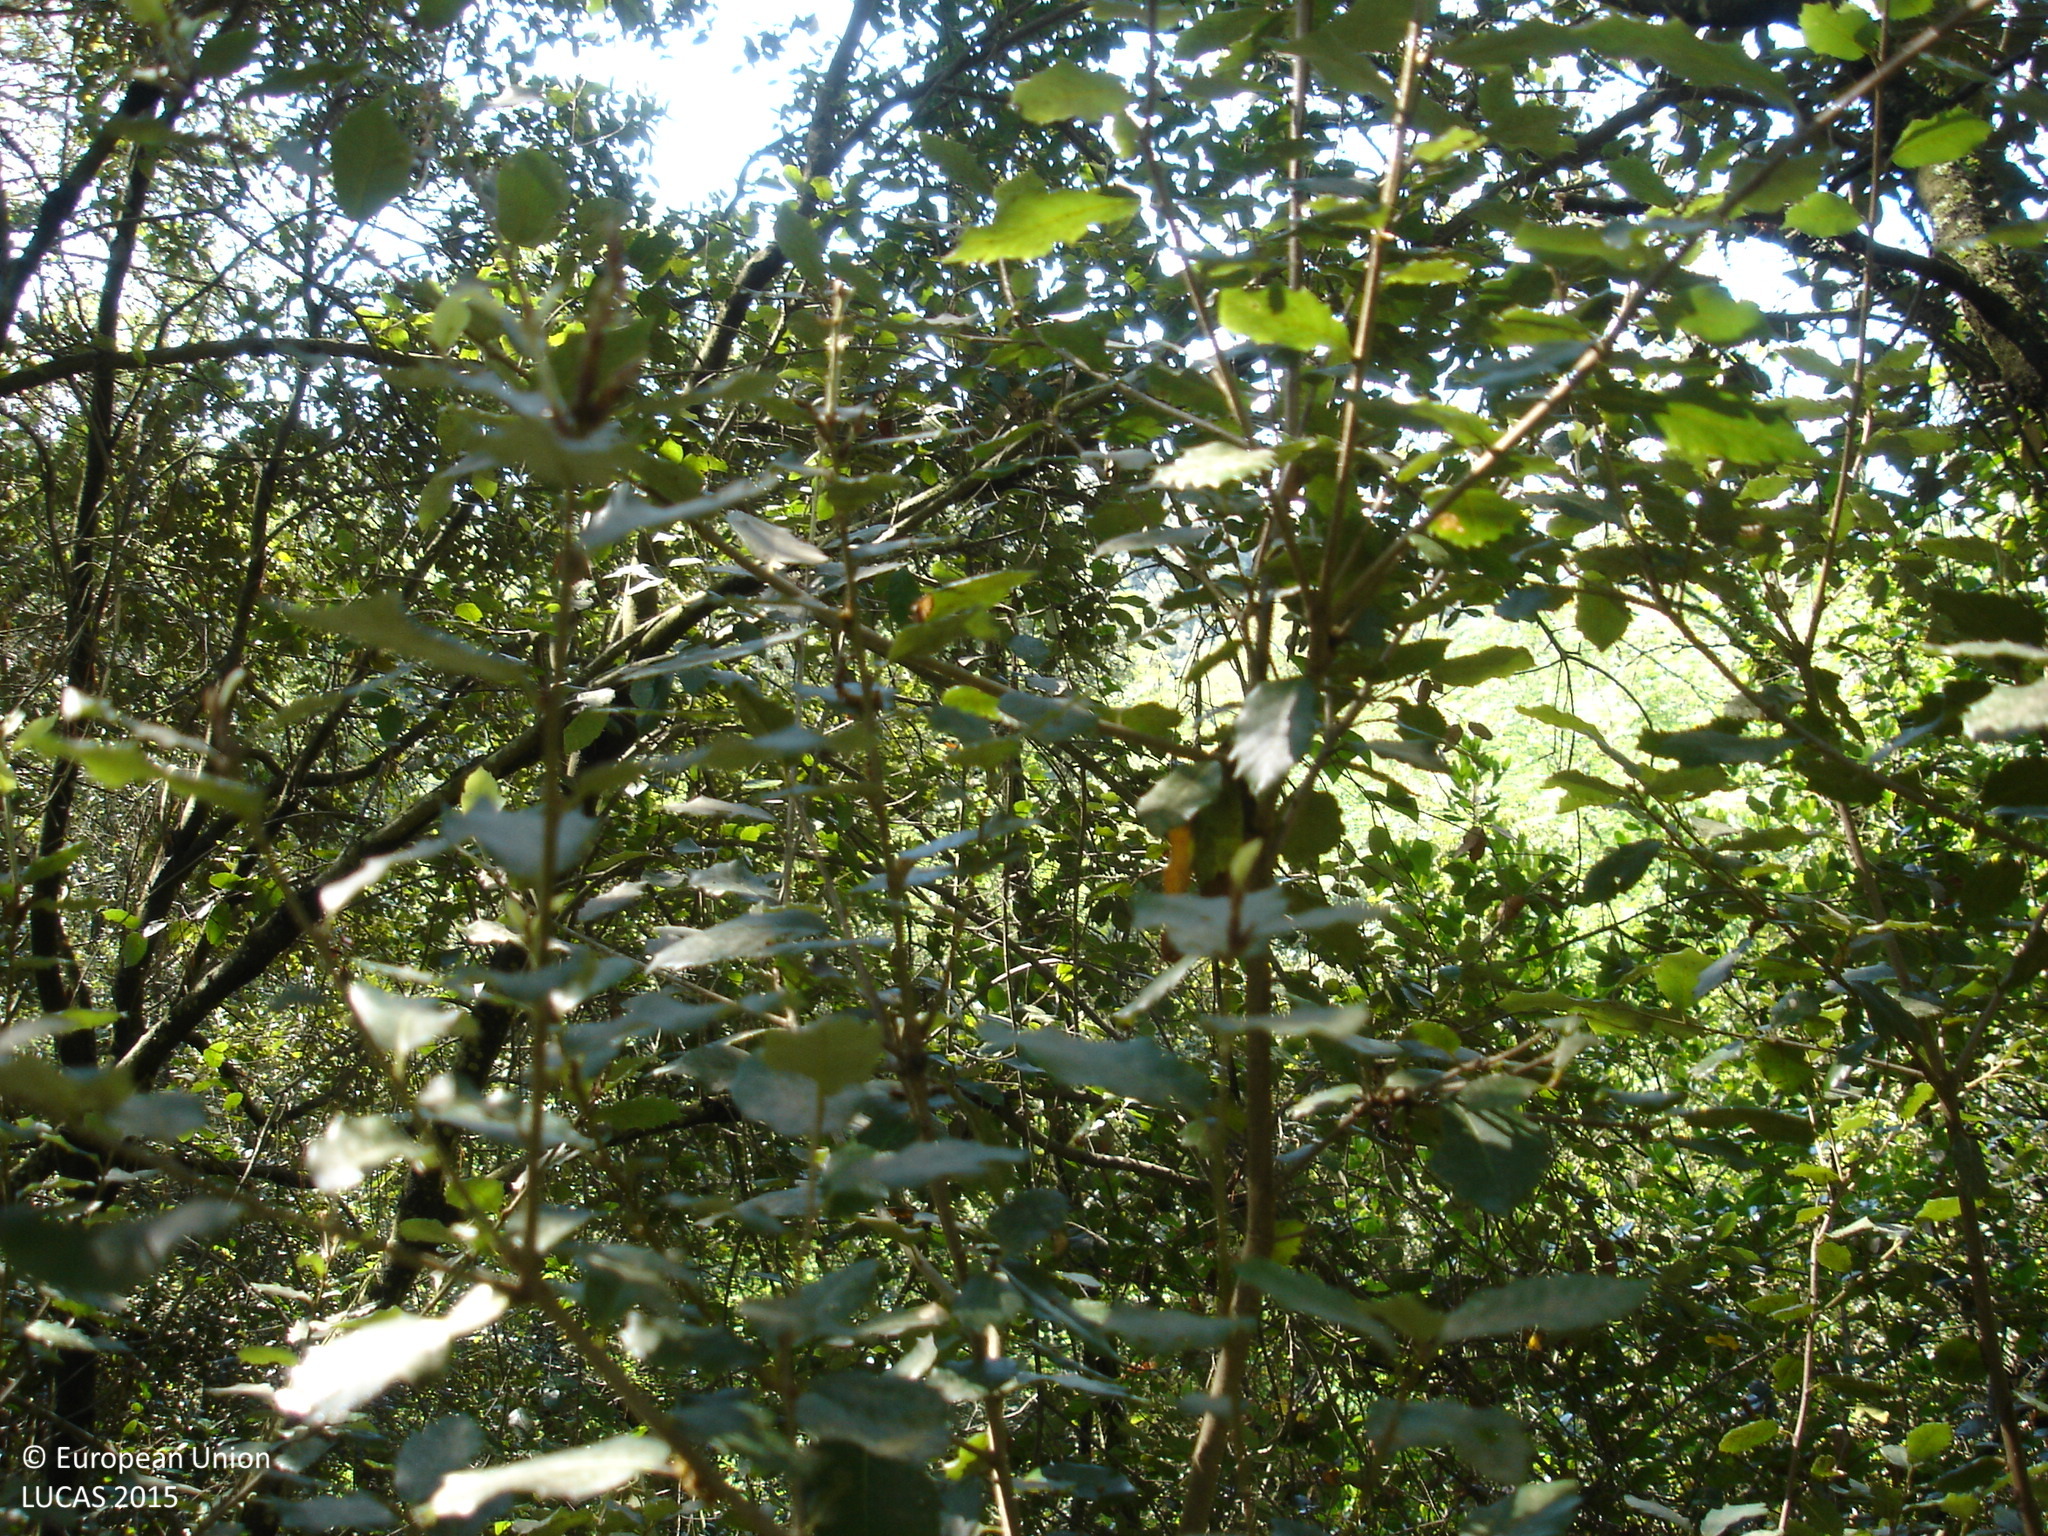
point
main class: Woodland
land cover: Broadleaved woodland
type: thermophilous deciduous forest
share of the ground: > 75 %
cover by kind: broadleaved forest trees 90 %, herbaceous plants 10 %
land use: Forestry
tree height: > 5 m
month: June
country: ES
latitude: 41.7824
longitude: 2.5686
